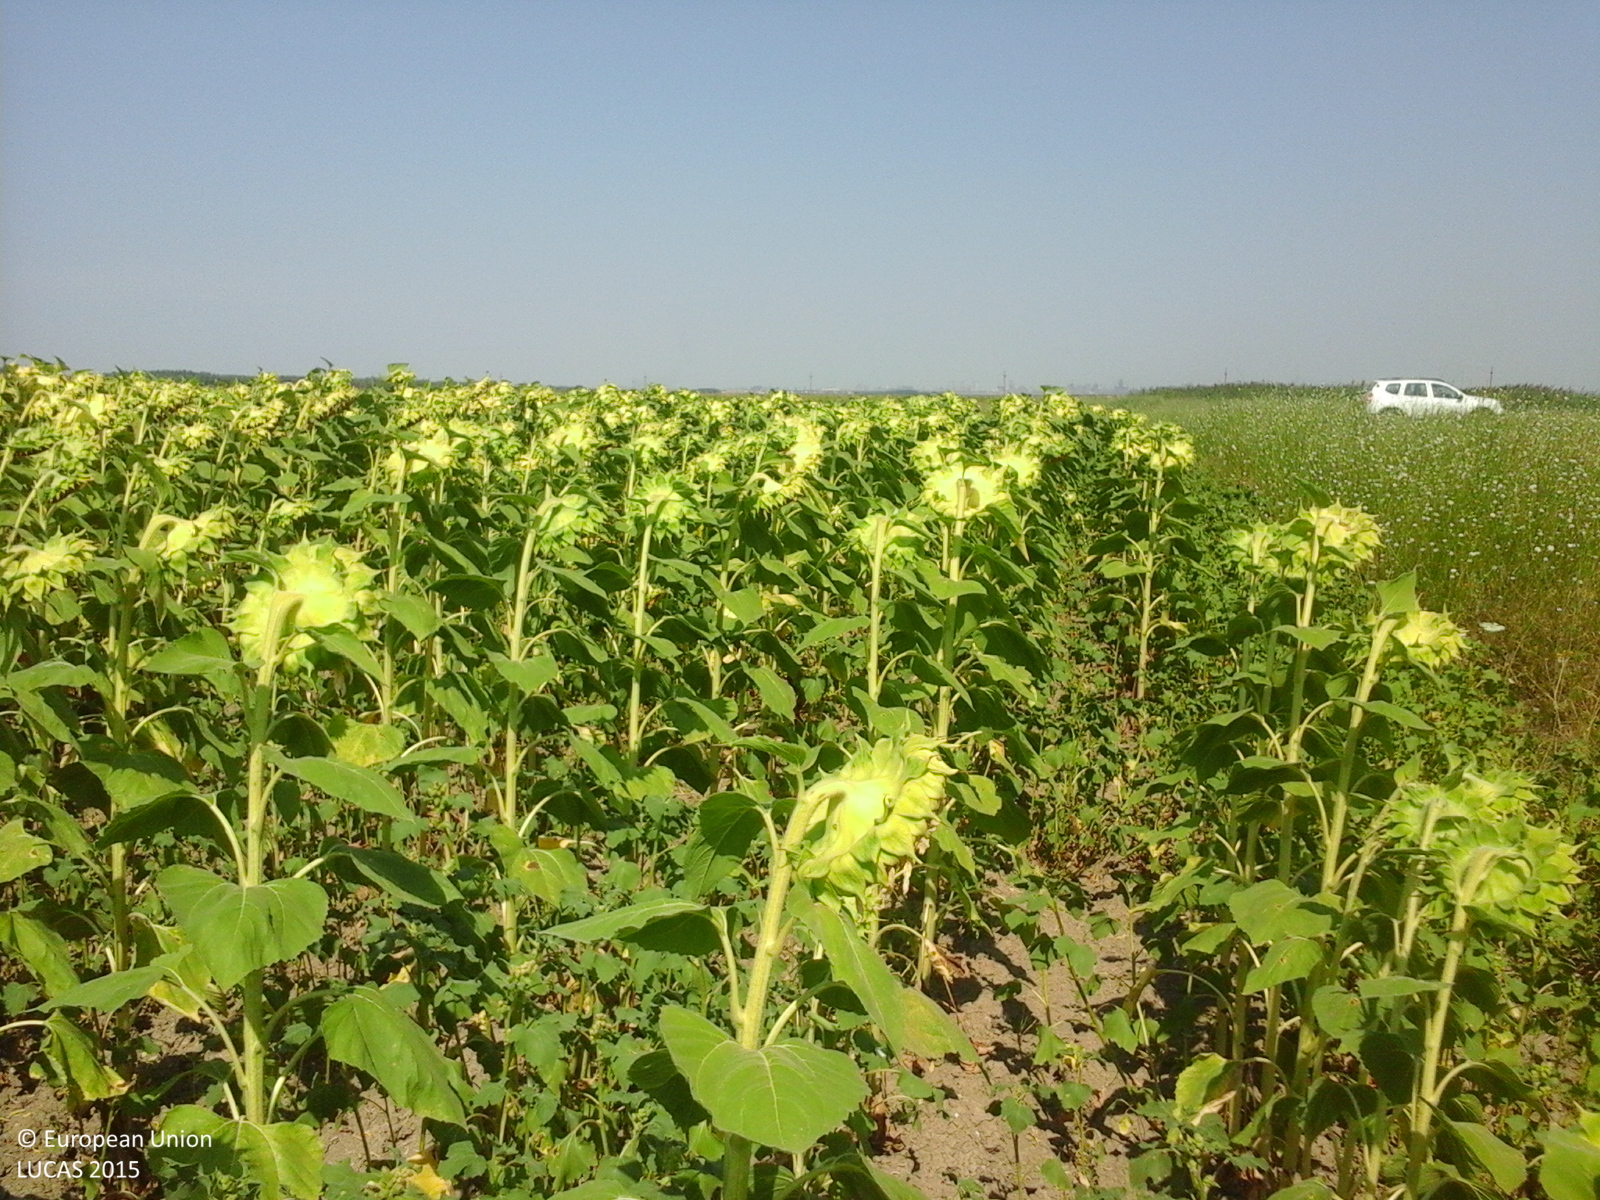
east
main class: Cropland
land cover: Sunflower
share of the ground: > 75 %
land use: Agriculture (excluding fallow land and kitchen gardens)
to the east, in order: Sunflower; Spontaneously vegetated surfaces; Ditches and canals; Spontaneously vegetated surfaces; Maize
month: August
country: RO
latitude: 45.3864
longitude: 27.8523
